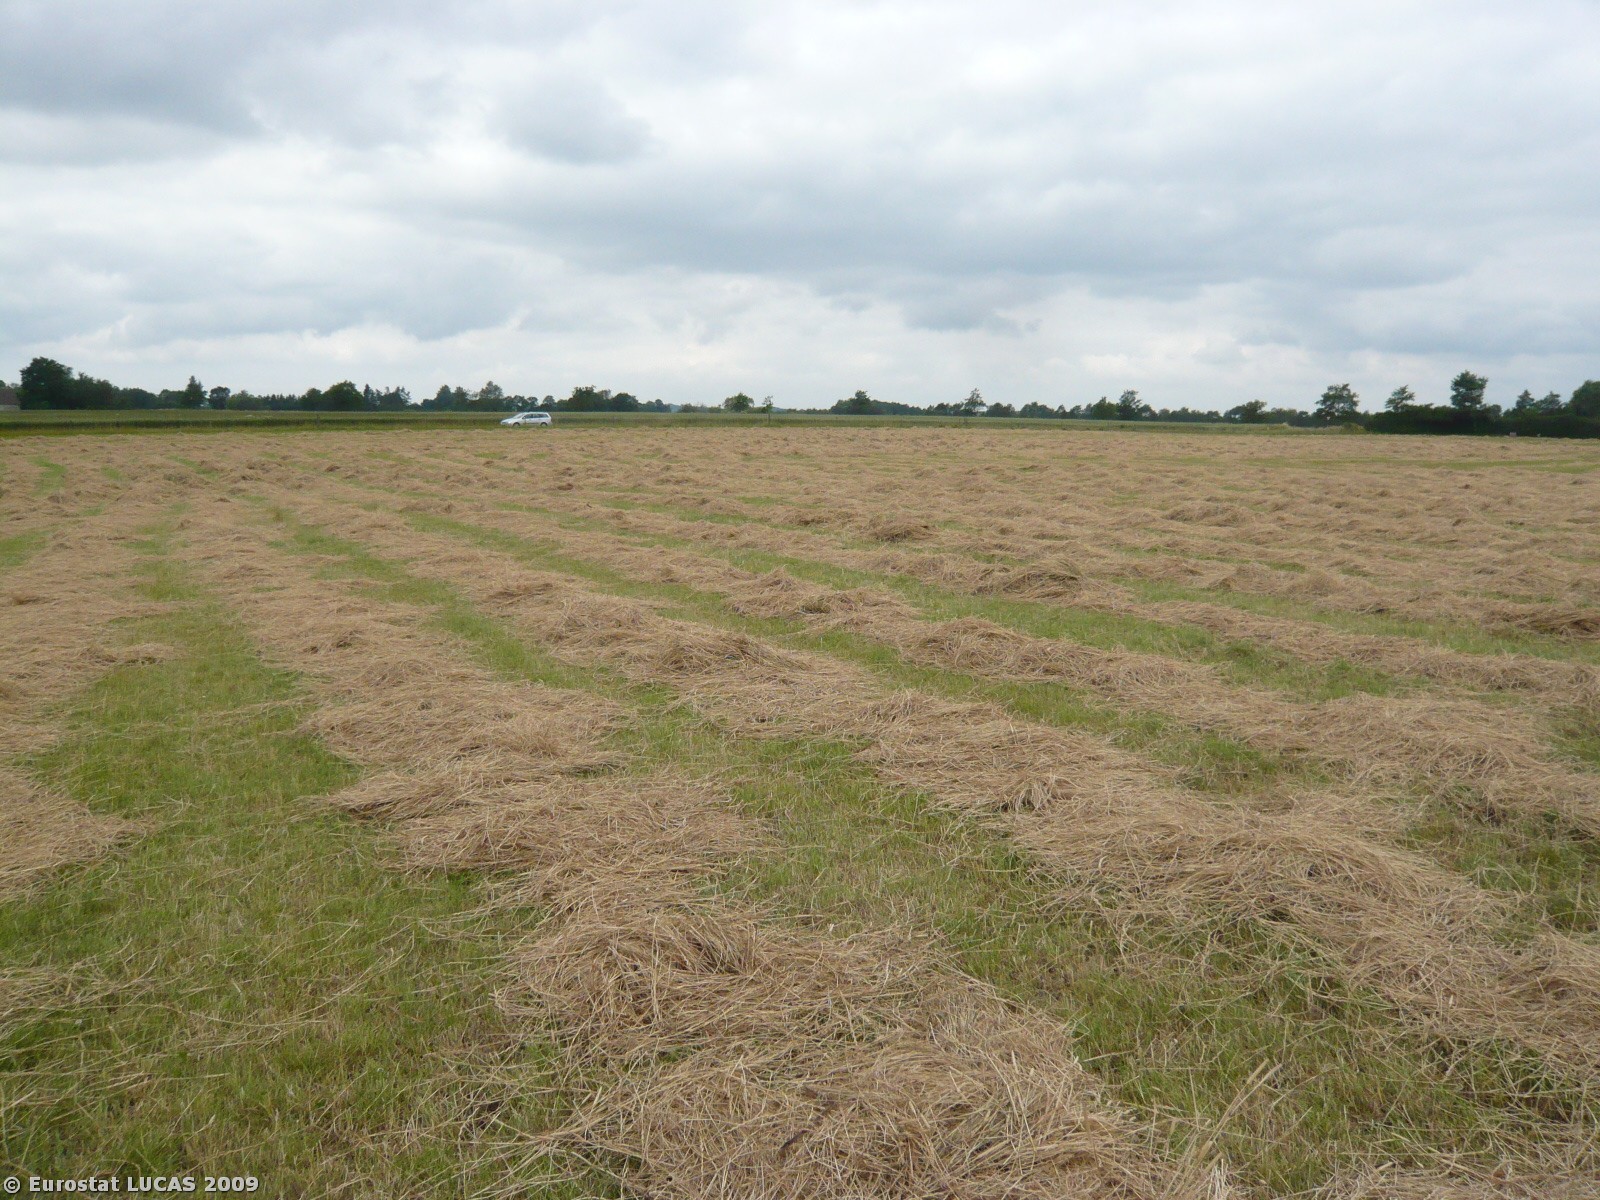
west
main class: Grassland
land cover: Grassland without tree/shrub cover
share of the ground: > 75 %
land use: Agriculture (excluding fallow land and kitchen gardens)
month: June
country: DK
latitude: 55.2708
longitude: 10.2673
